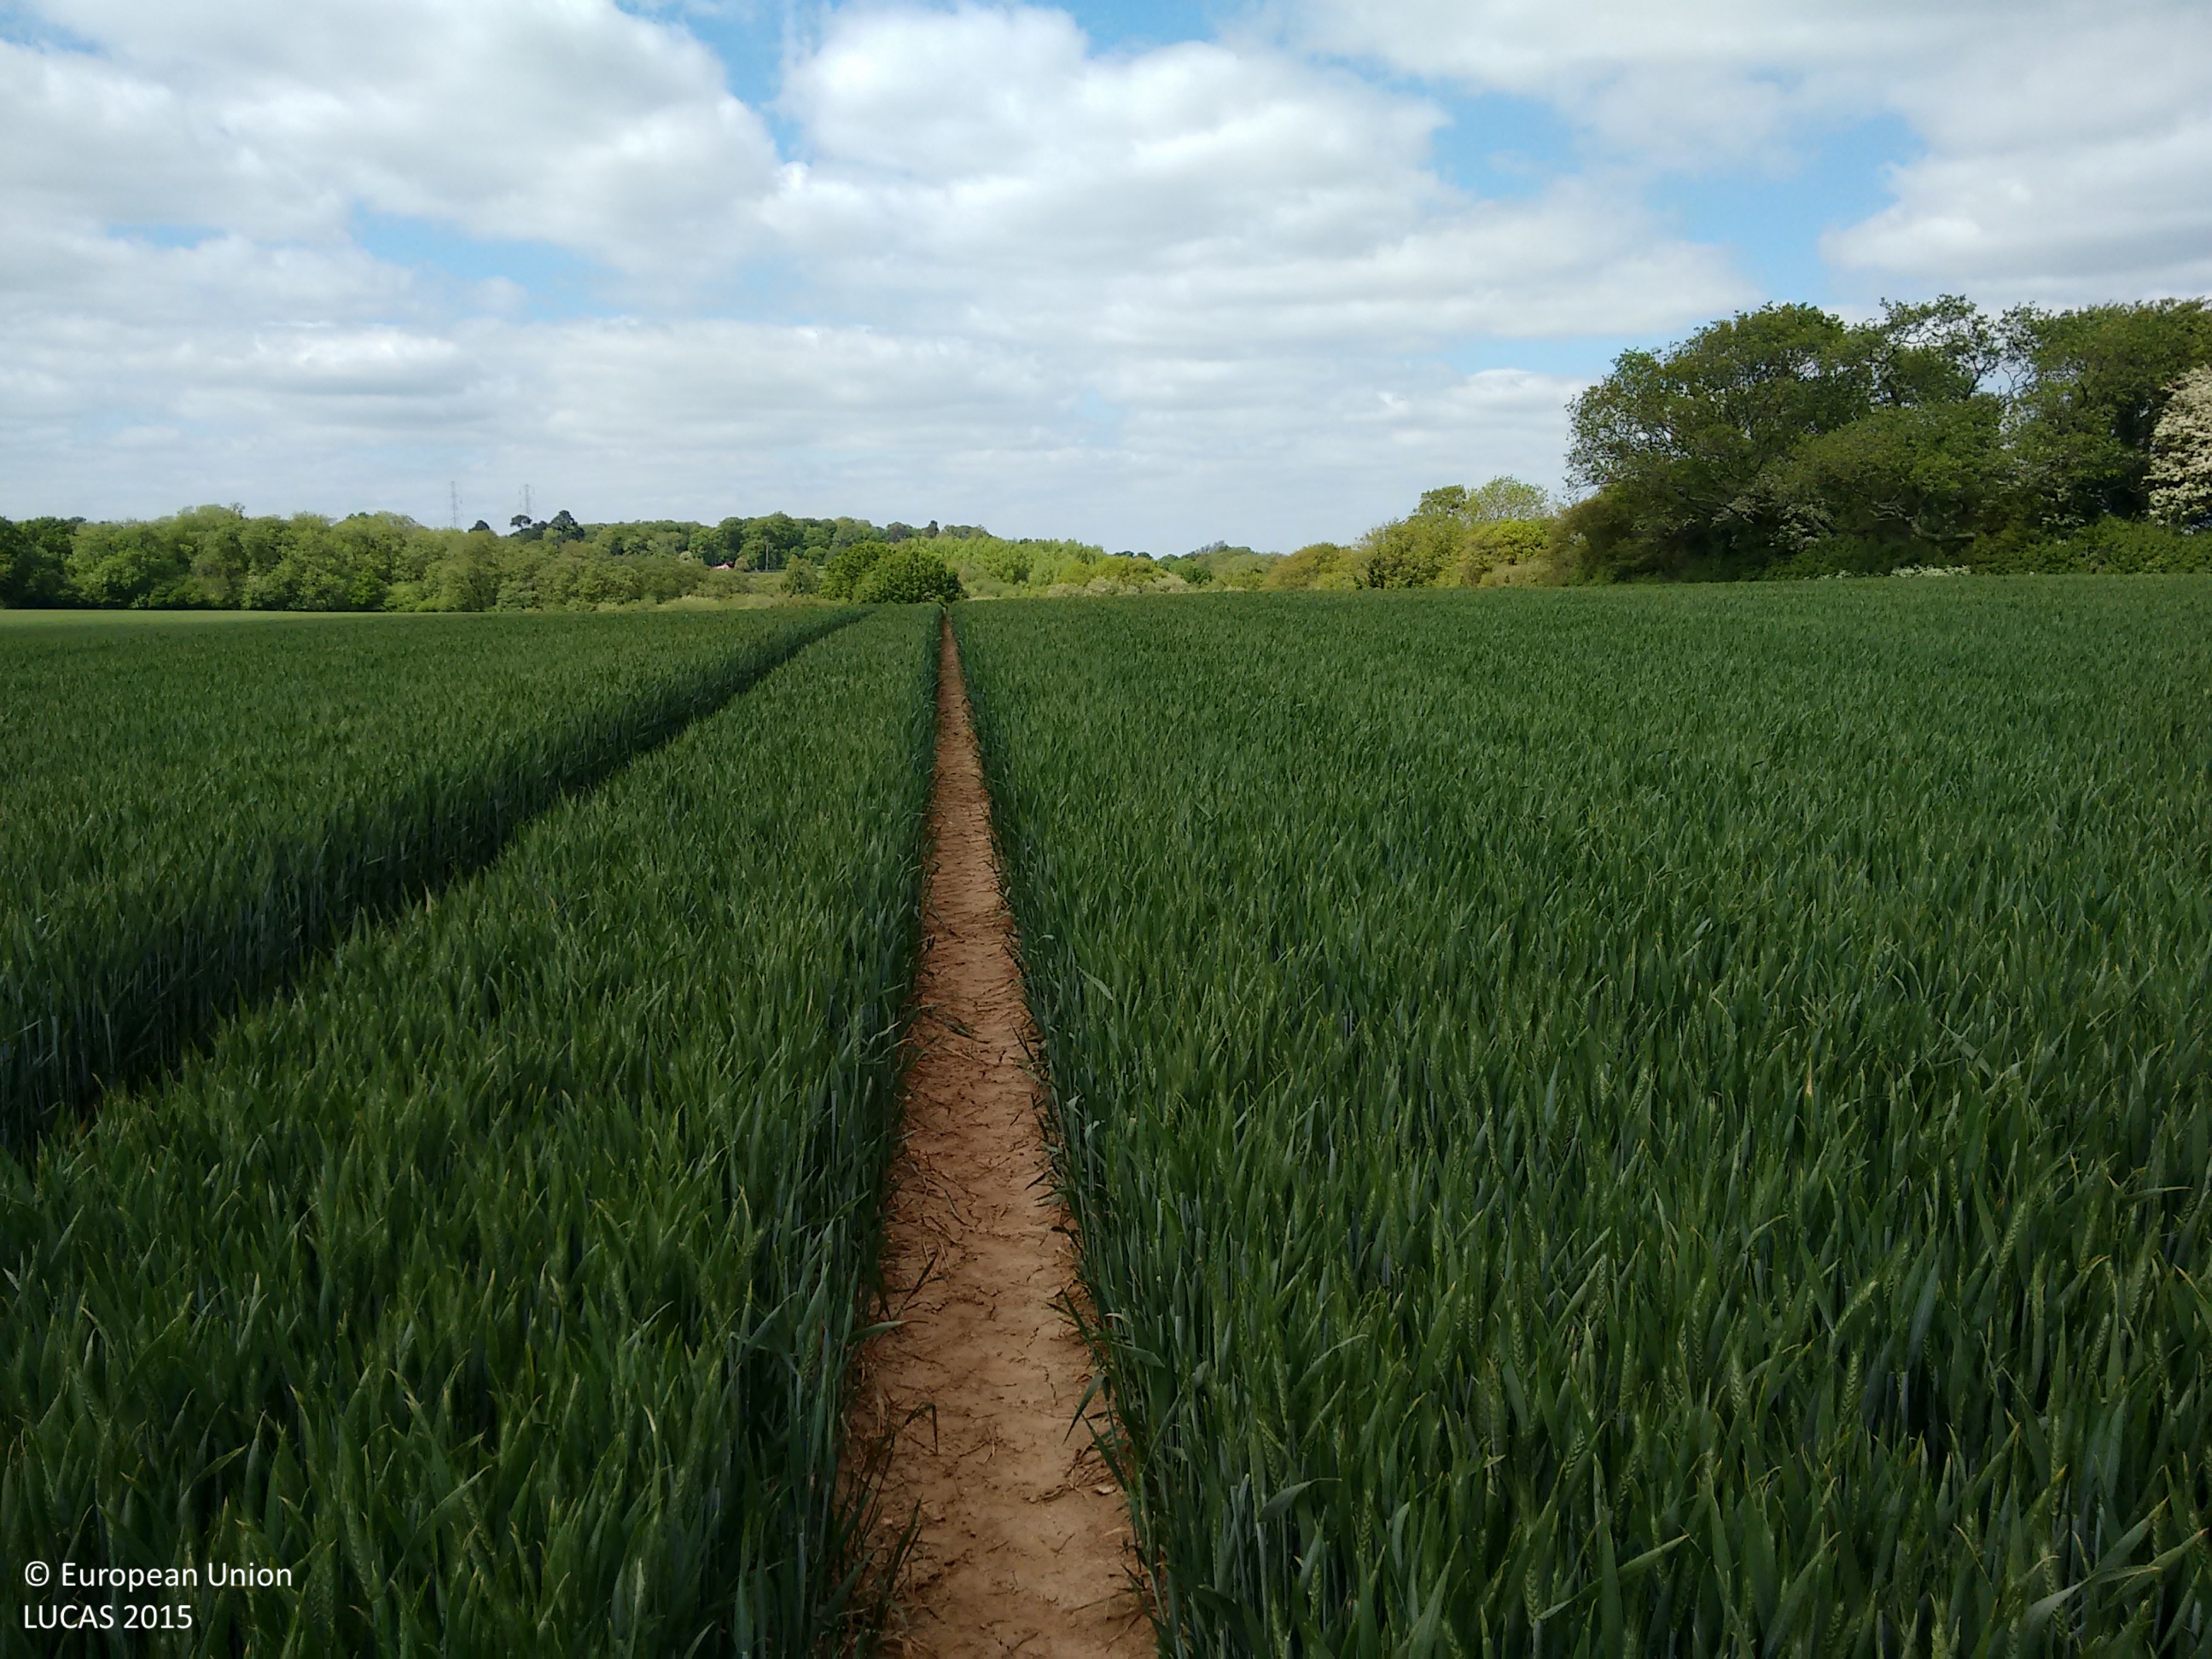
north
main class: Cropland
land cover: Common wheat
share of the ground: > 75 %
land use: Agriculture (excluding fallow land and kitchen gardens)
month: May
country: GB
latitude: 50.8610
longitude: -1.0556
